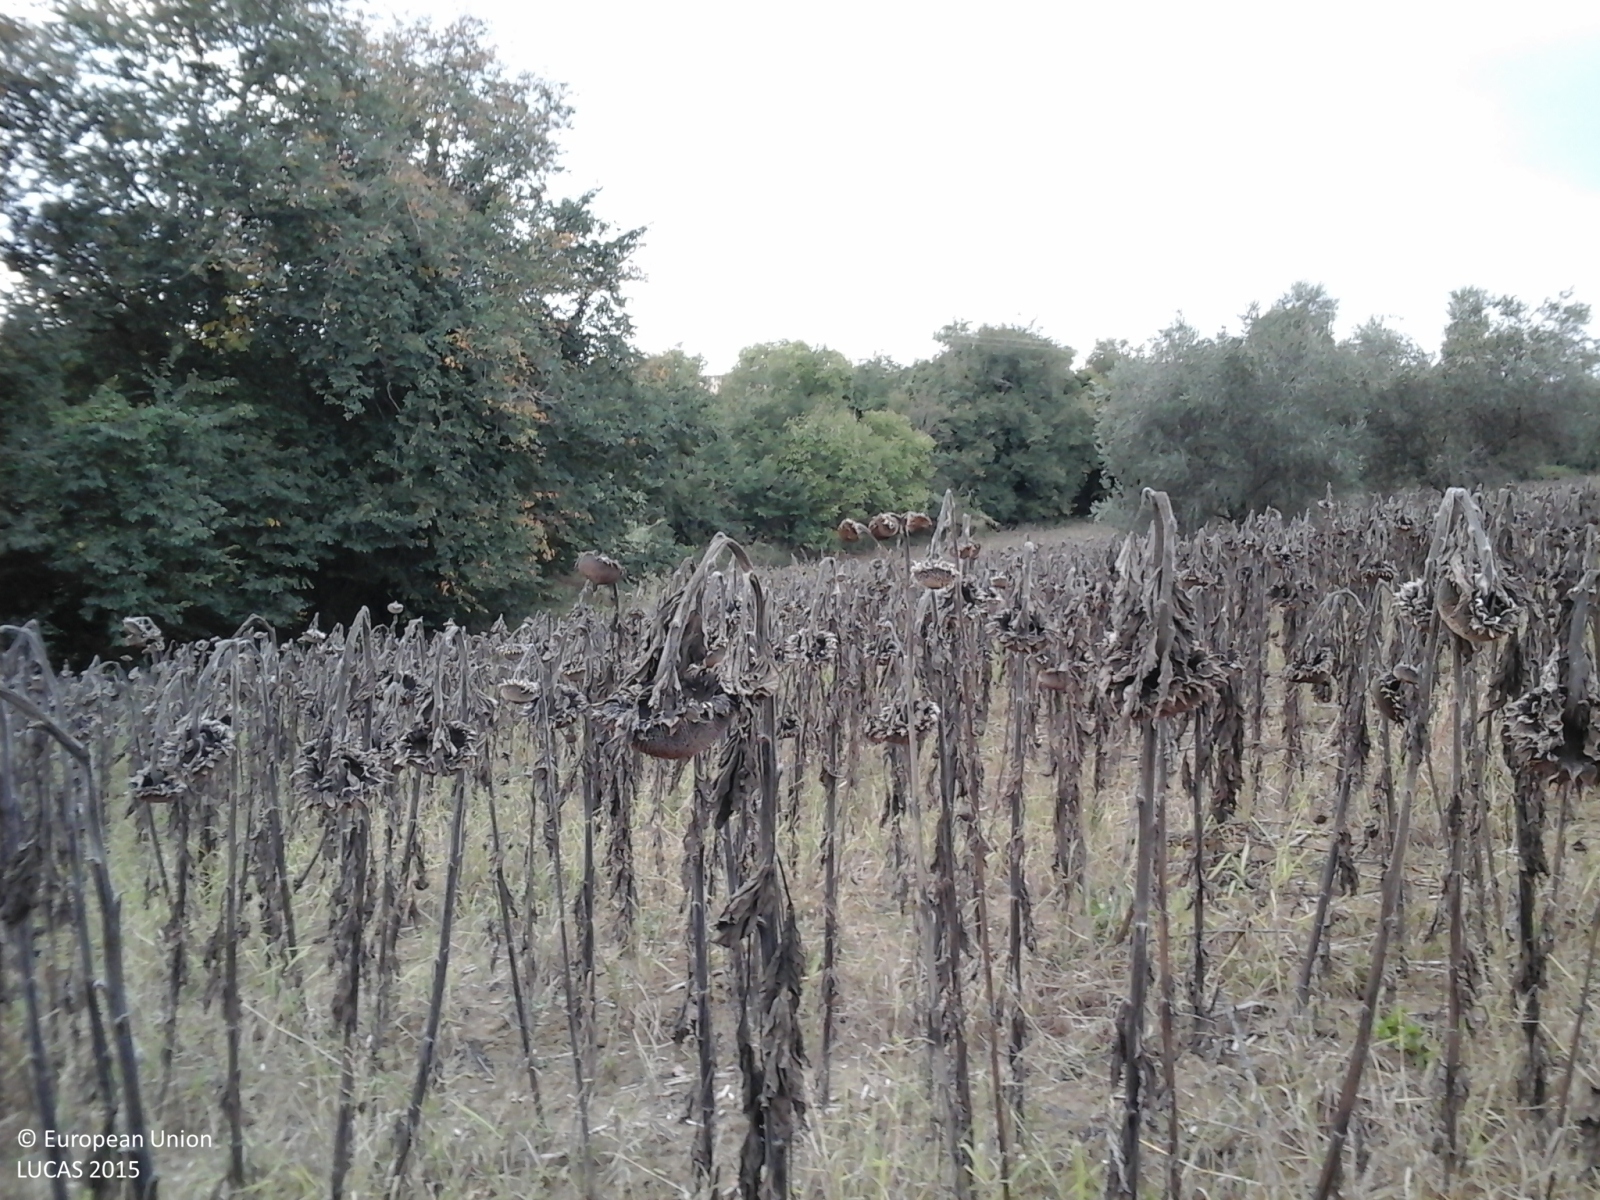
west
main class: Cropland
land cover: Sunflower
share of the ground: > 75 %
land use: Agriculture (excluding fallow land and kitchen gardens)
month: October
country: IT
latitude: 43.5799
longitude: 13.1749
